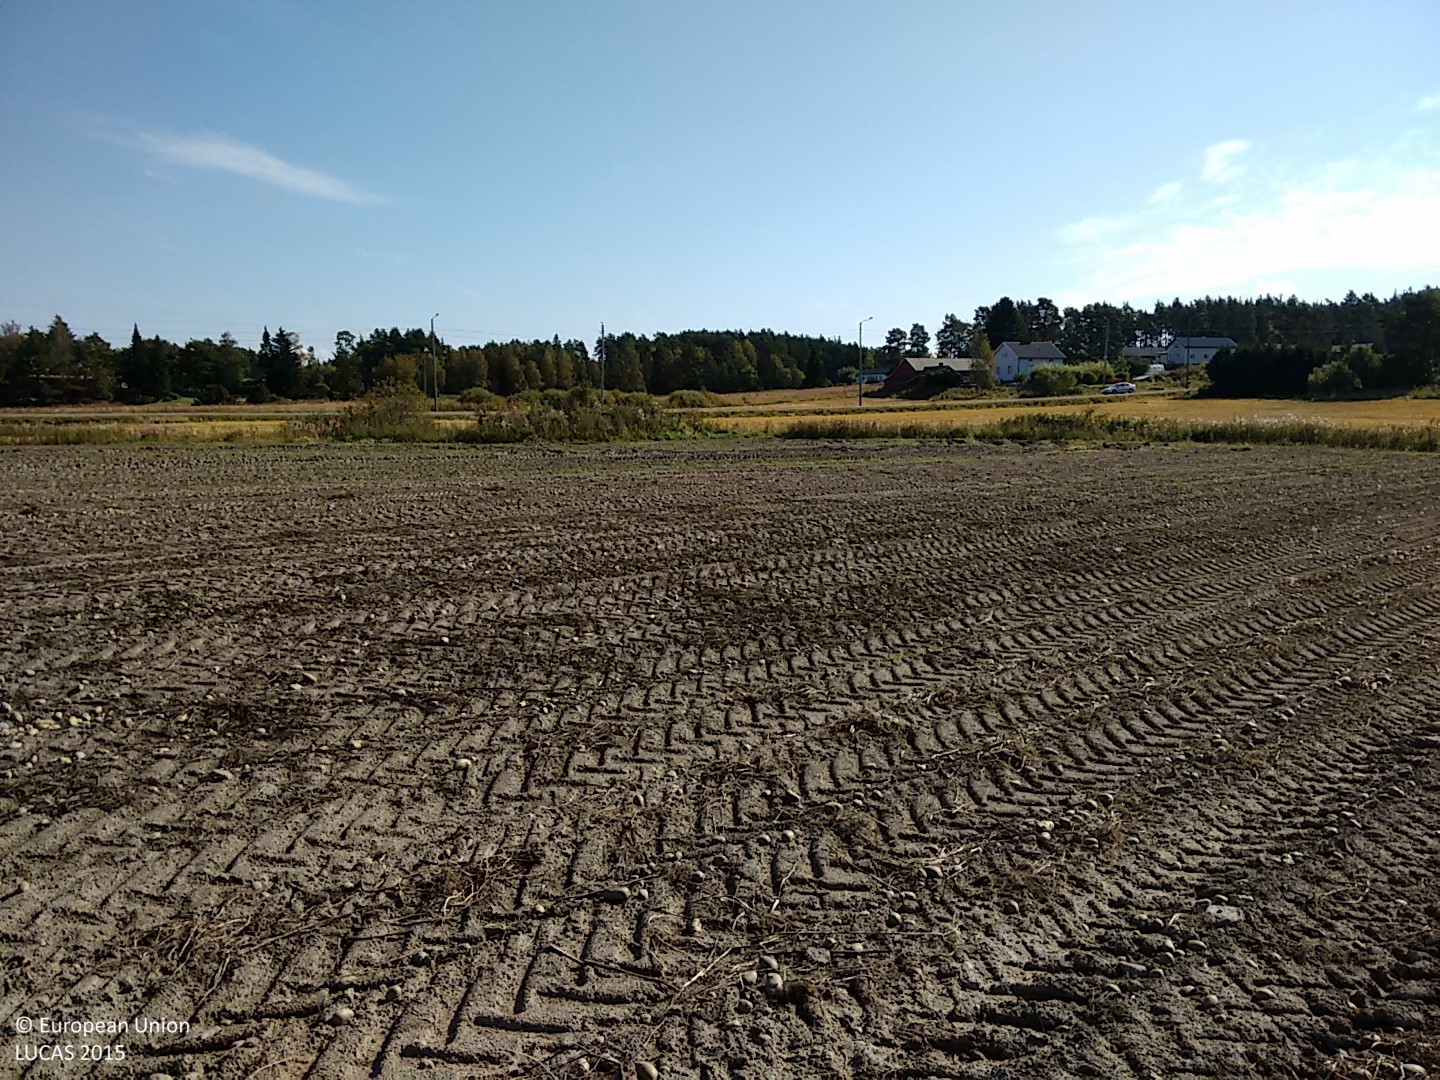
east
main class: Cropland
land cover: Potatoes
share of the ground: < 10 %
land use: Agriculture (excluding fallow land and kitchen gardens)
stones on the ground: < 10 %
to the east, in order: Potatoes; Shruby margins; Ditches and canals; Shruby margins; Common wheat; Grass margins; Ditches and canals; Grass margins; Paved roads, cycling and walking lanes; Grass margins; Ditches and canals; Electric lines; Grass margins; Tracks; Grass margins; Ditches and canals; Grass margins; Electric lines; Common wheat; Grass margins; Inland marshes; Grass margins; Common wheat
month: September
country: FI
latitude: 60.9141
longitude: 21.6929
